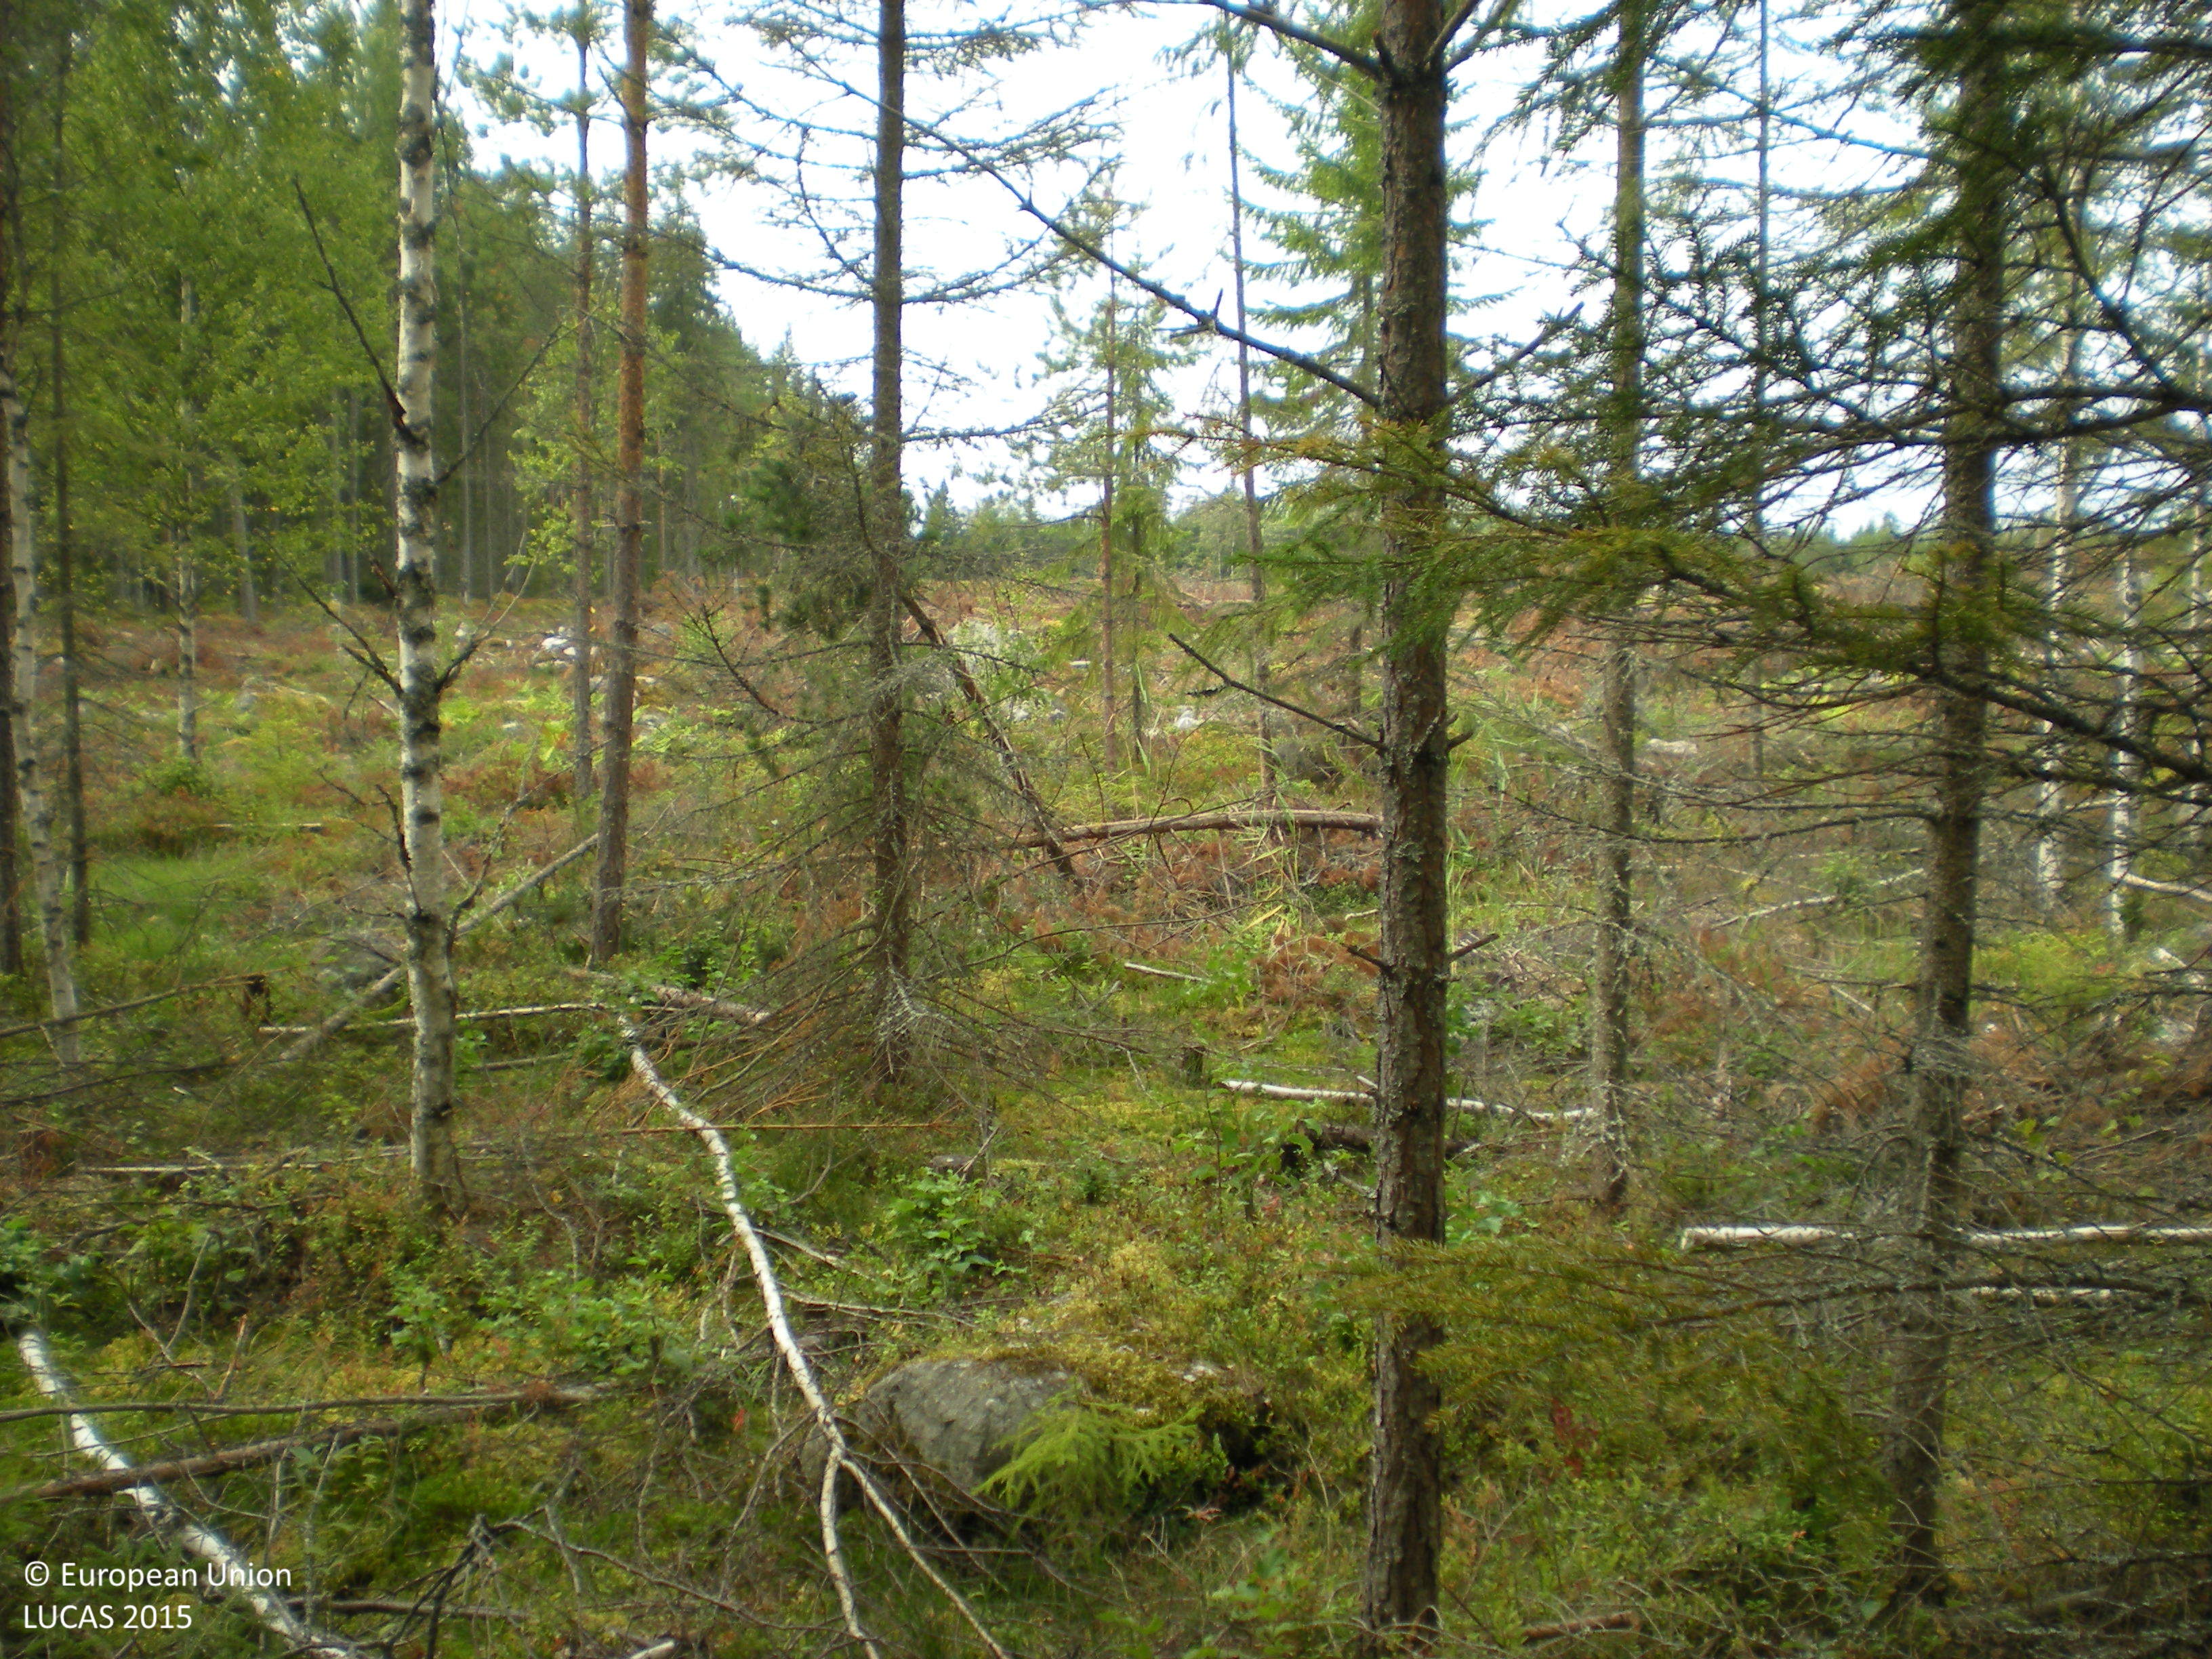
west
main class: Woodland
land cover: Other coniferous woodland
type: boreal forest
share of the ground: 50 - 75 %
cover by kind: coniferous forest trees 60 %, lichens and mosses 15 %, shrubs 10 %, broadleaved forest trees 5 %, herbaceous plants 5 %, consolidated bare surface 5 %
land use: Forestry
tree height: > 5 m
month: August
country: SE
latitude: 60.4419
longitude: 17.6790
